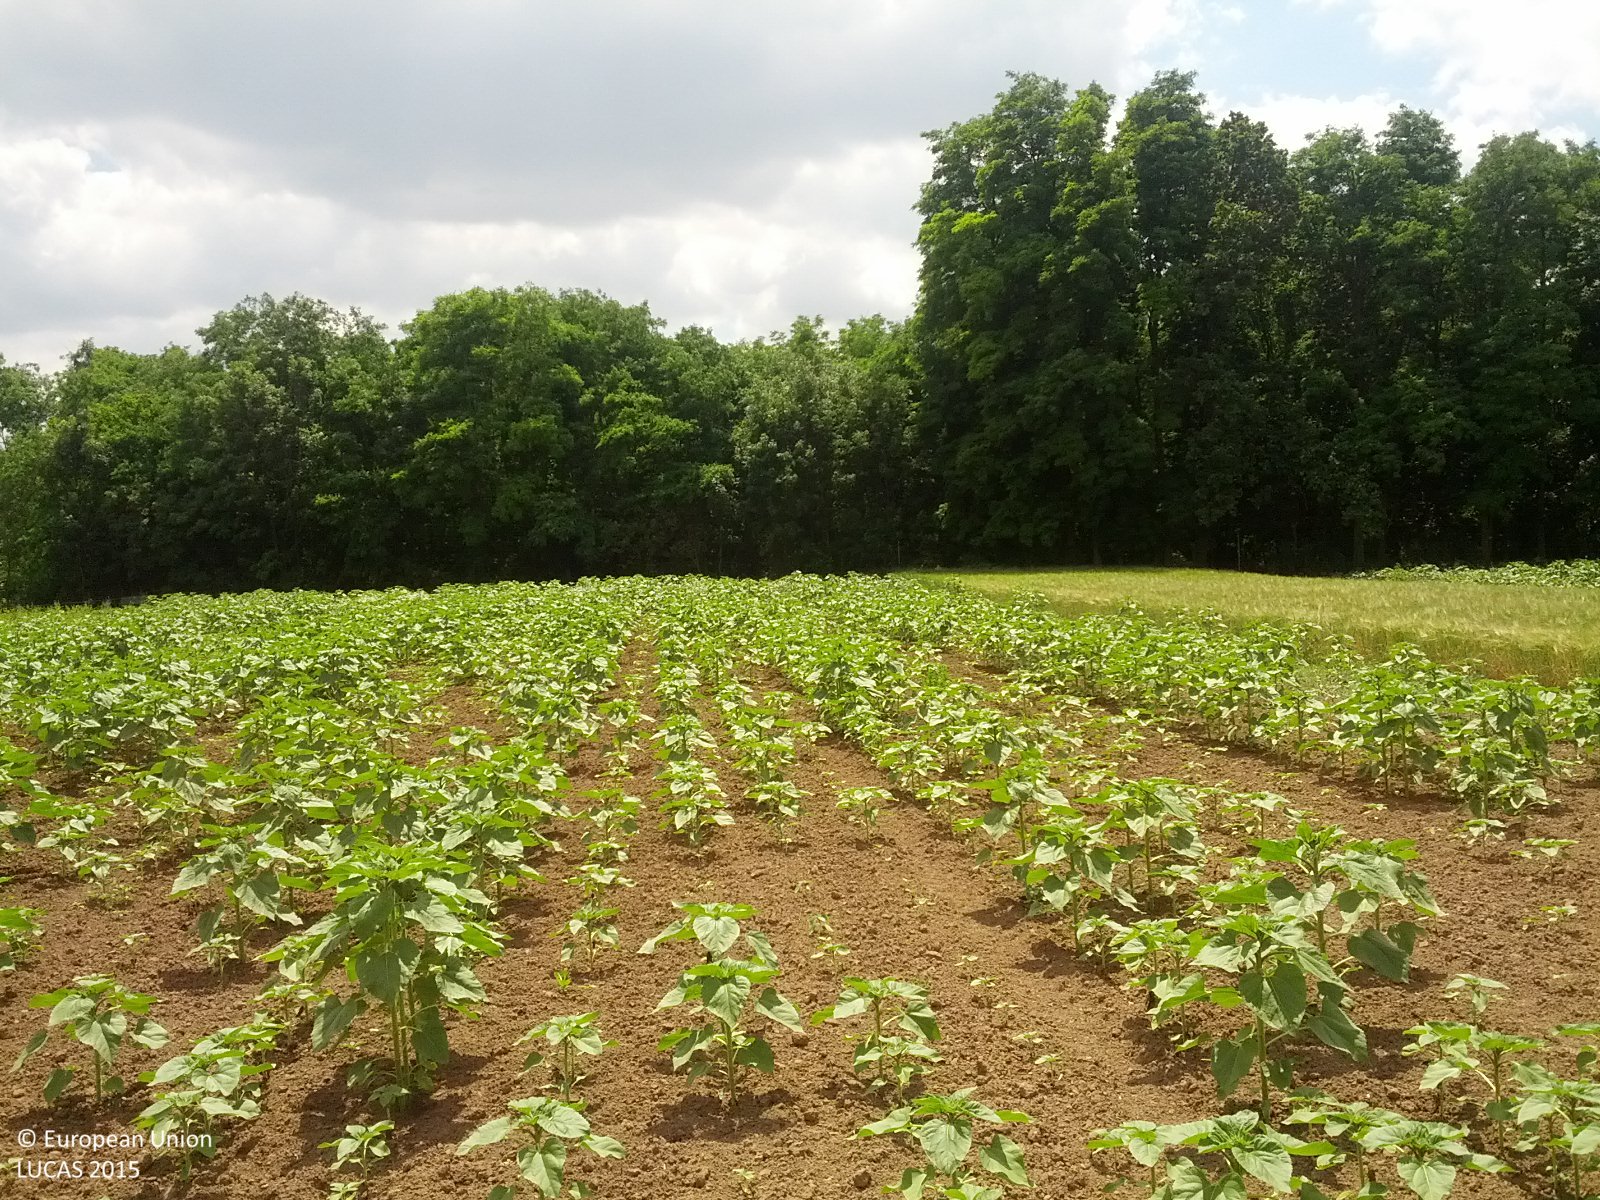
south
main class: Cropland
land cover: Sunflower
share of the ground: 25 - 50 %
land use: Agriculture (excluding fallow land and kitchen gardens)
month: June
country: AT
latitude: 48.4367
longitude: 16.6704
